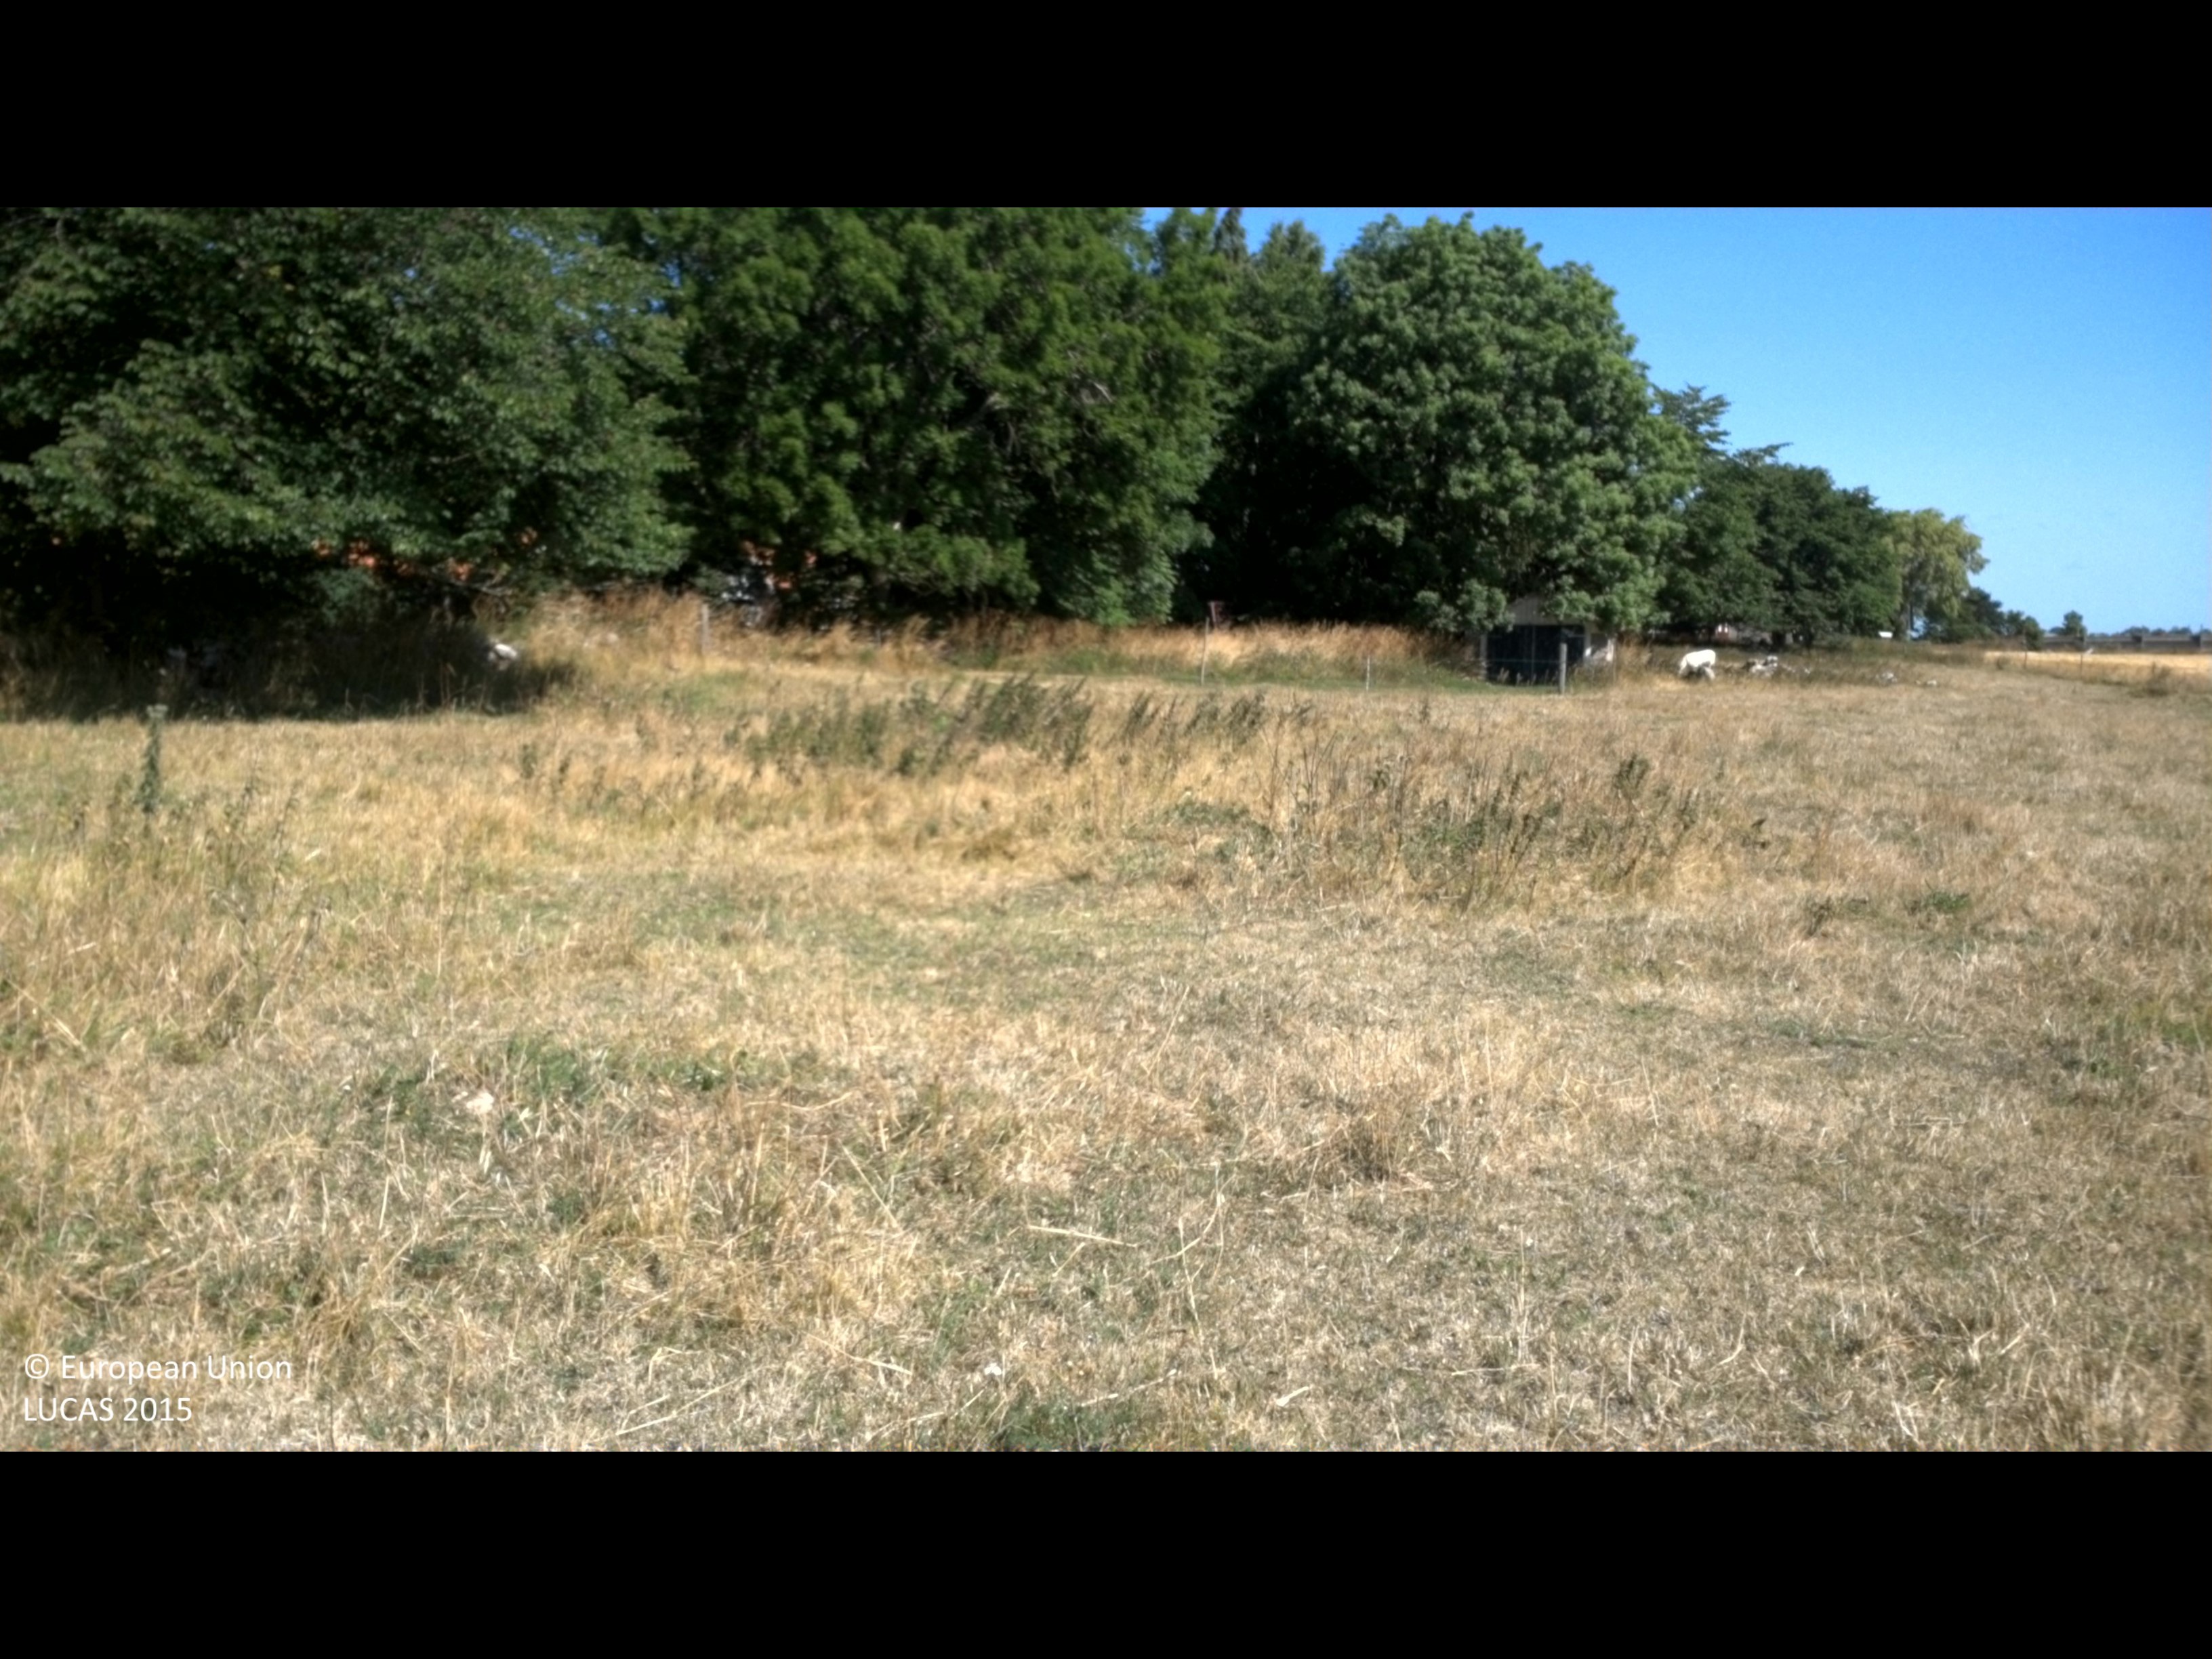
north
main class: Grassland
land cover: Grassland without tree/shrub cover
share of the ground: > 75 %
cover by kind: herbaceous plants 100 %
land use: Agriculture (excluding fallow land and kitchen gardens)
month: July
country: SE
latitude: 56.2588
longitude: 16.4756
